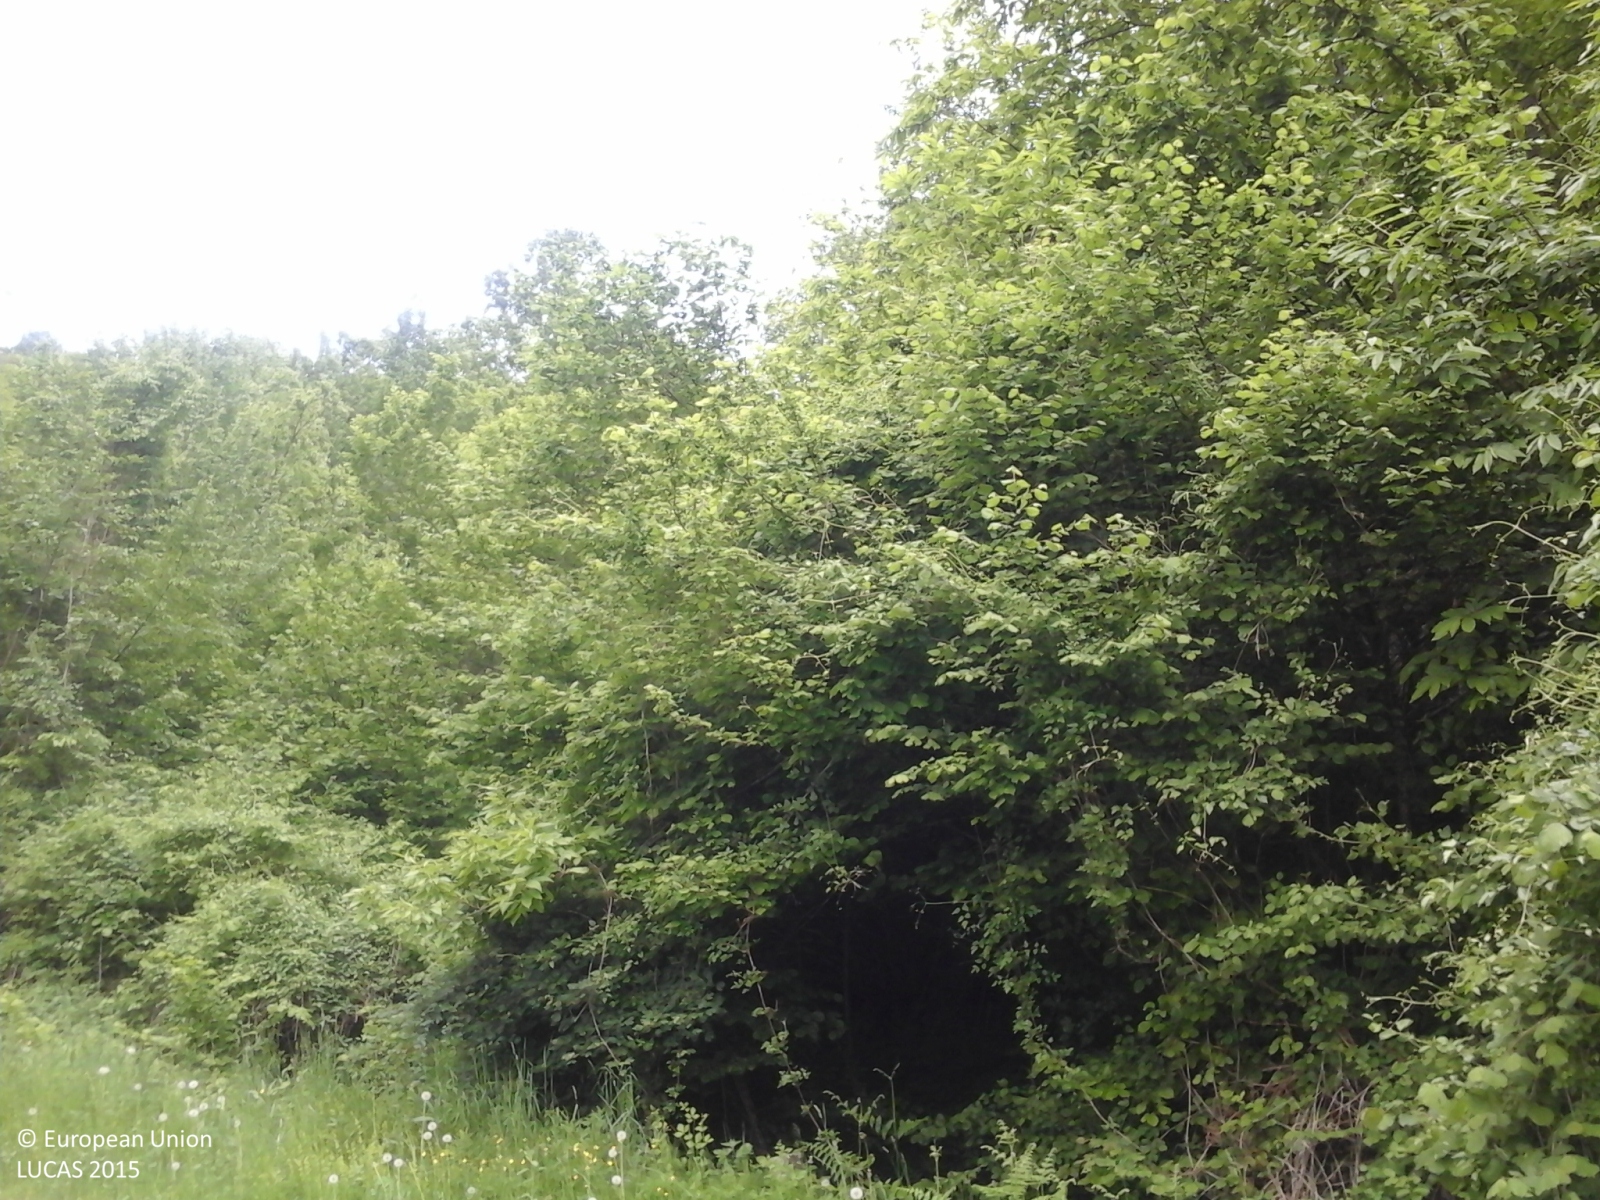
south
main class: Woodland
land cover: Broadleaved woodland
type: thermophilous deciduous forest
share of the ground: > 75 %
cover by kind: broadleaved forest trees 70 %, shrubs 30 %
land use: Forestry
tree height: > 5 m
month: May
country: IT
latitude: 44.4761
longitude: 9.6111
